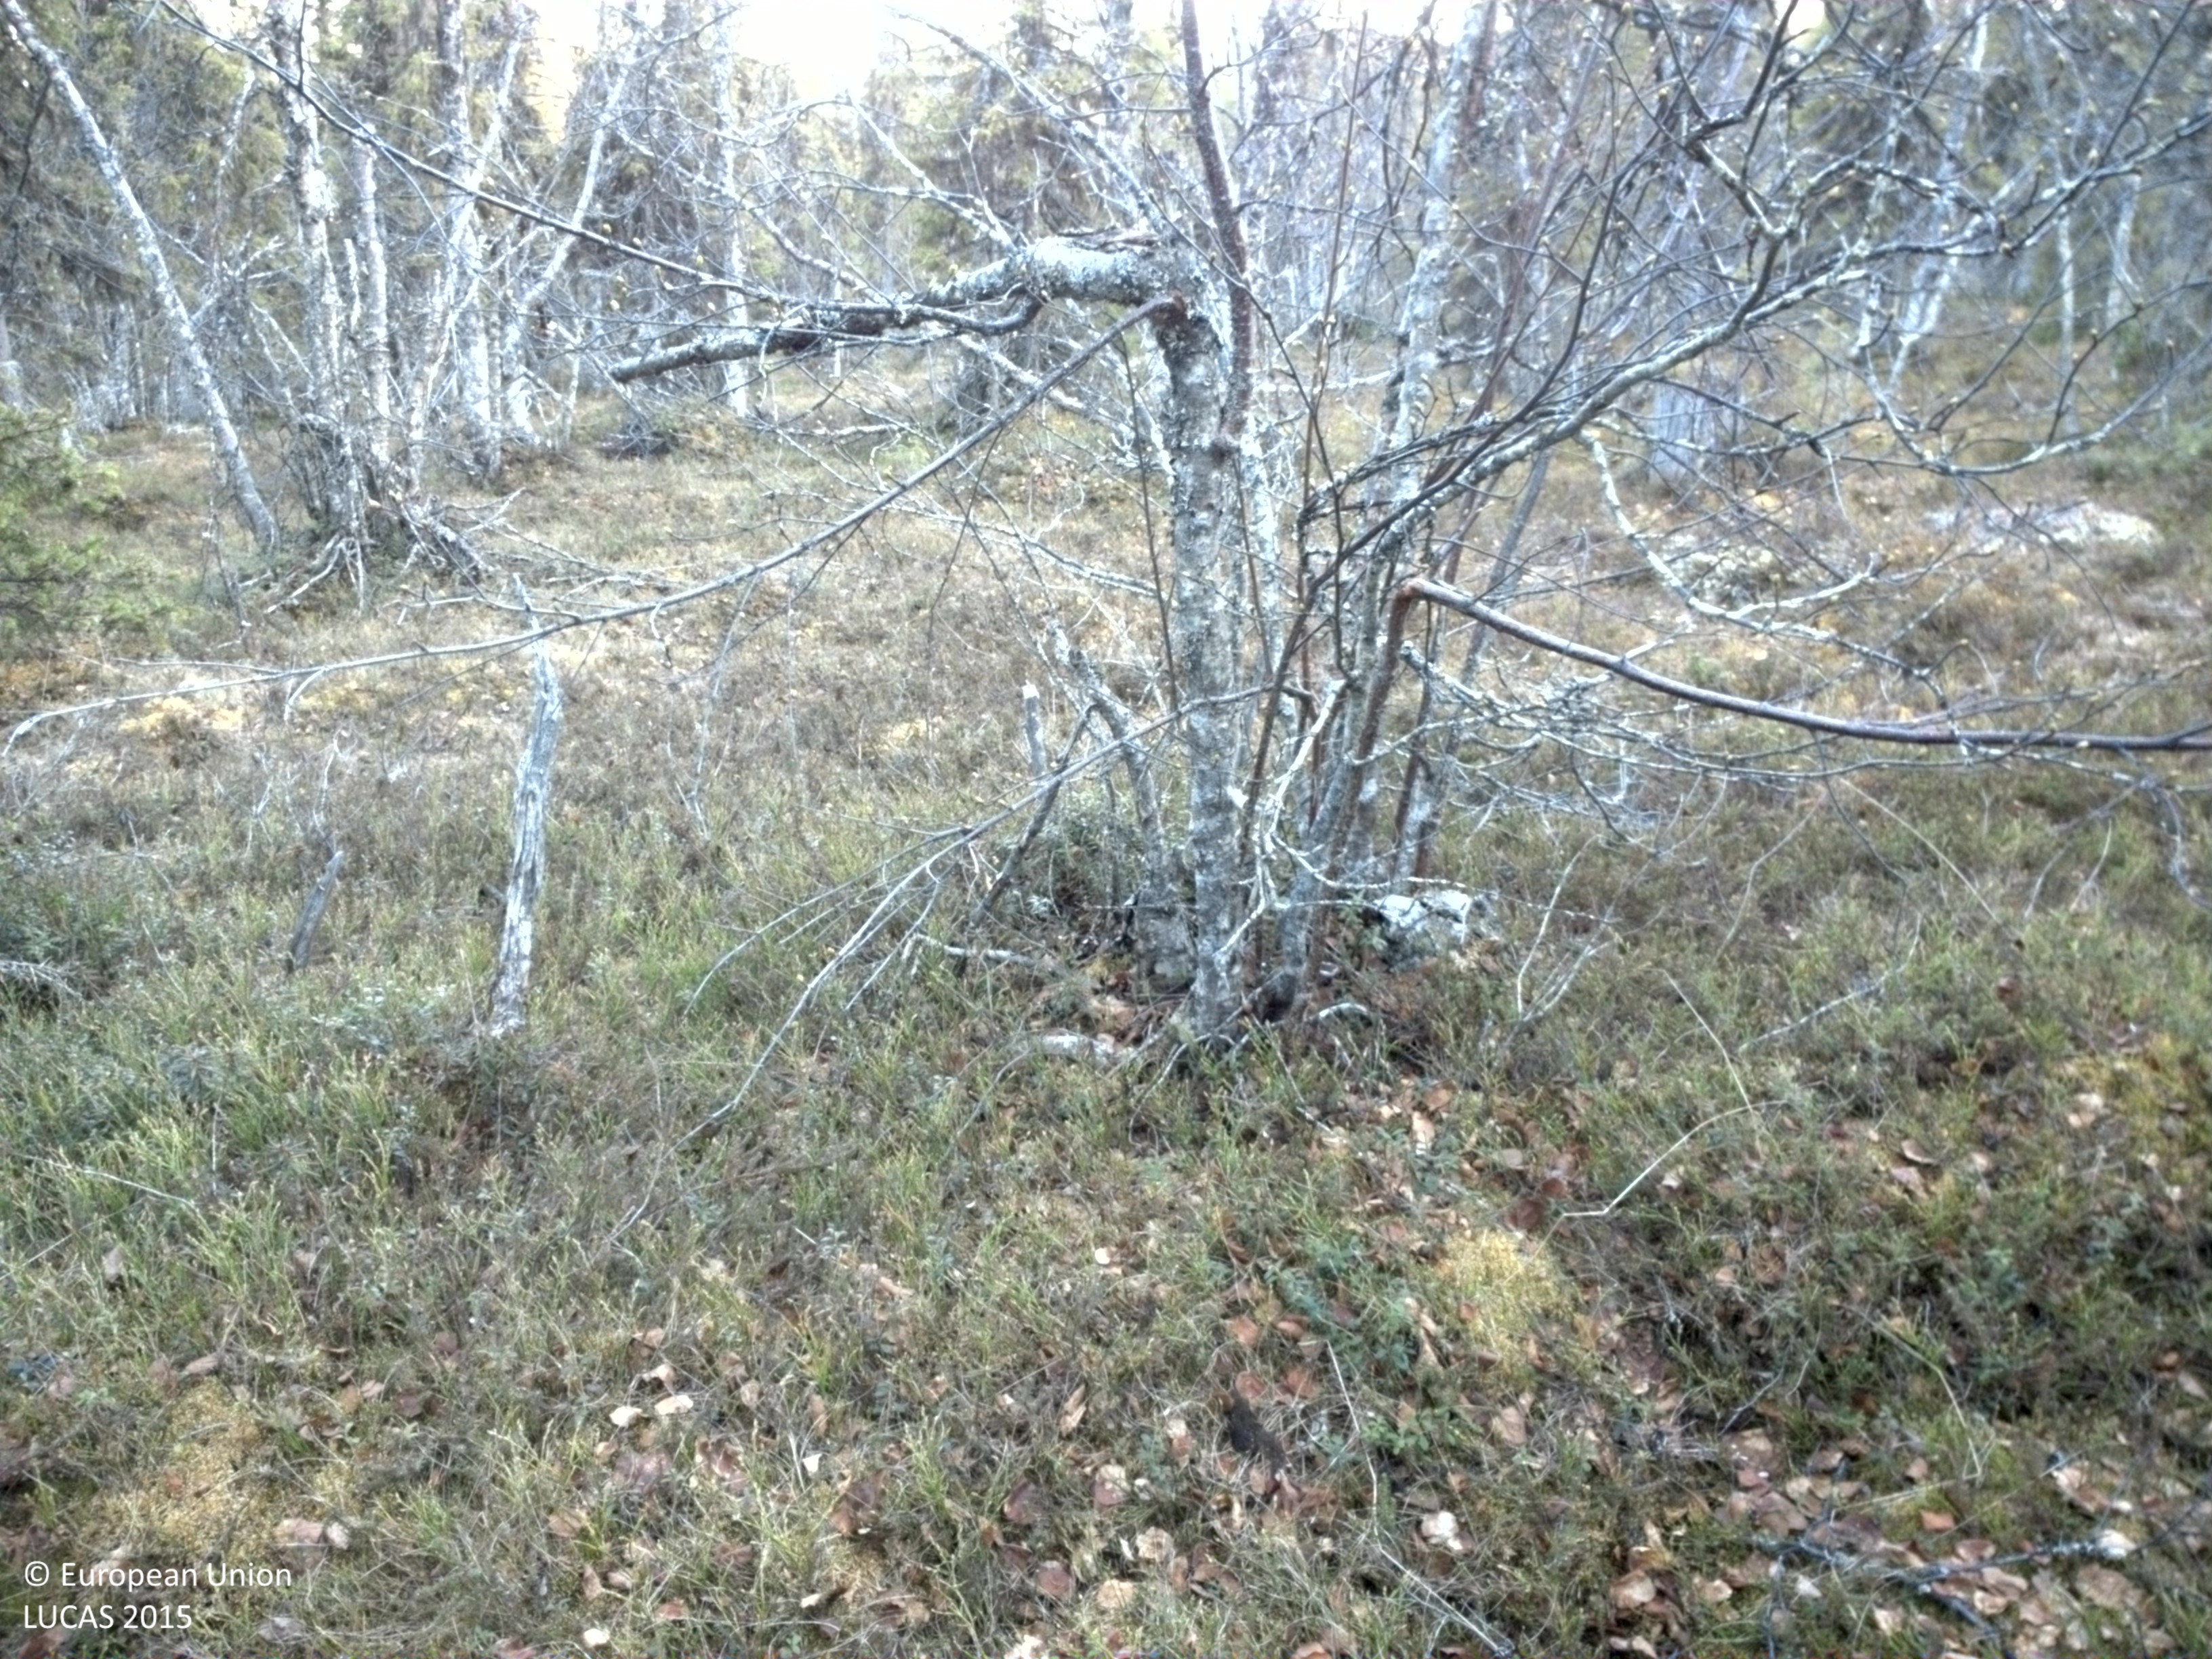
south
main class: Woodland
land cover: Spruce dominated mixed woodland
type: boreal forest
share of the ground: 50 - 75 %
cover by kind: coniferous forest trees 50 %, shrubs 30 %, broadleaved forest trees 20 %
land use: Forestry
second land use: Amenities, museums, leisure
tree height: > 5 m
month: June
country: SE
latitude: 67.2671
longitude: 20.1724
